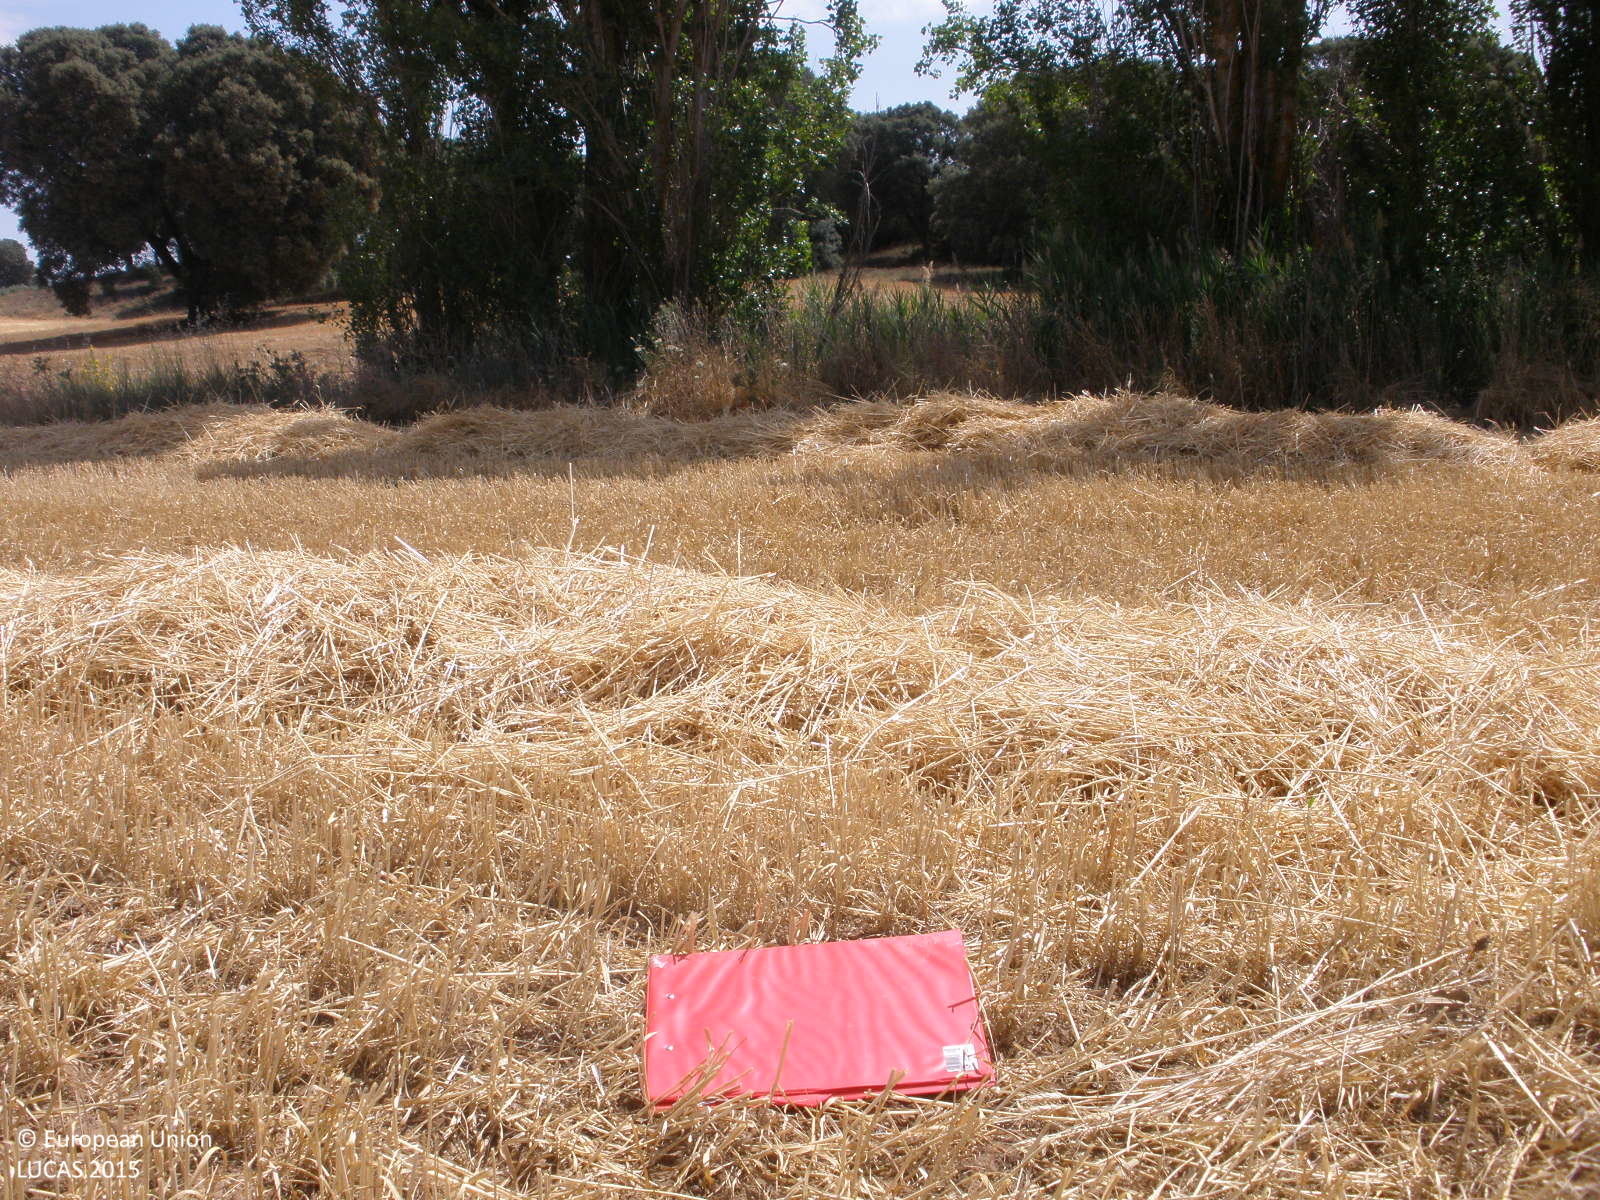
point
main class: Cropland
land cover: Common wheat
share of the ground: < 10 %
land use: Agriculture (excluding fallow land and kitchen gardens)
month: July
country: ES
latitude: 39.8896
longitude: -3.1568
